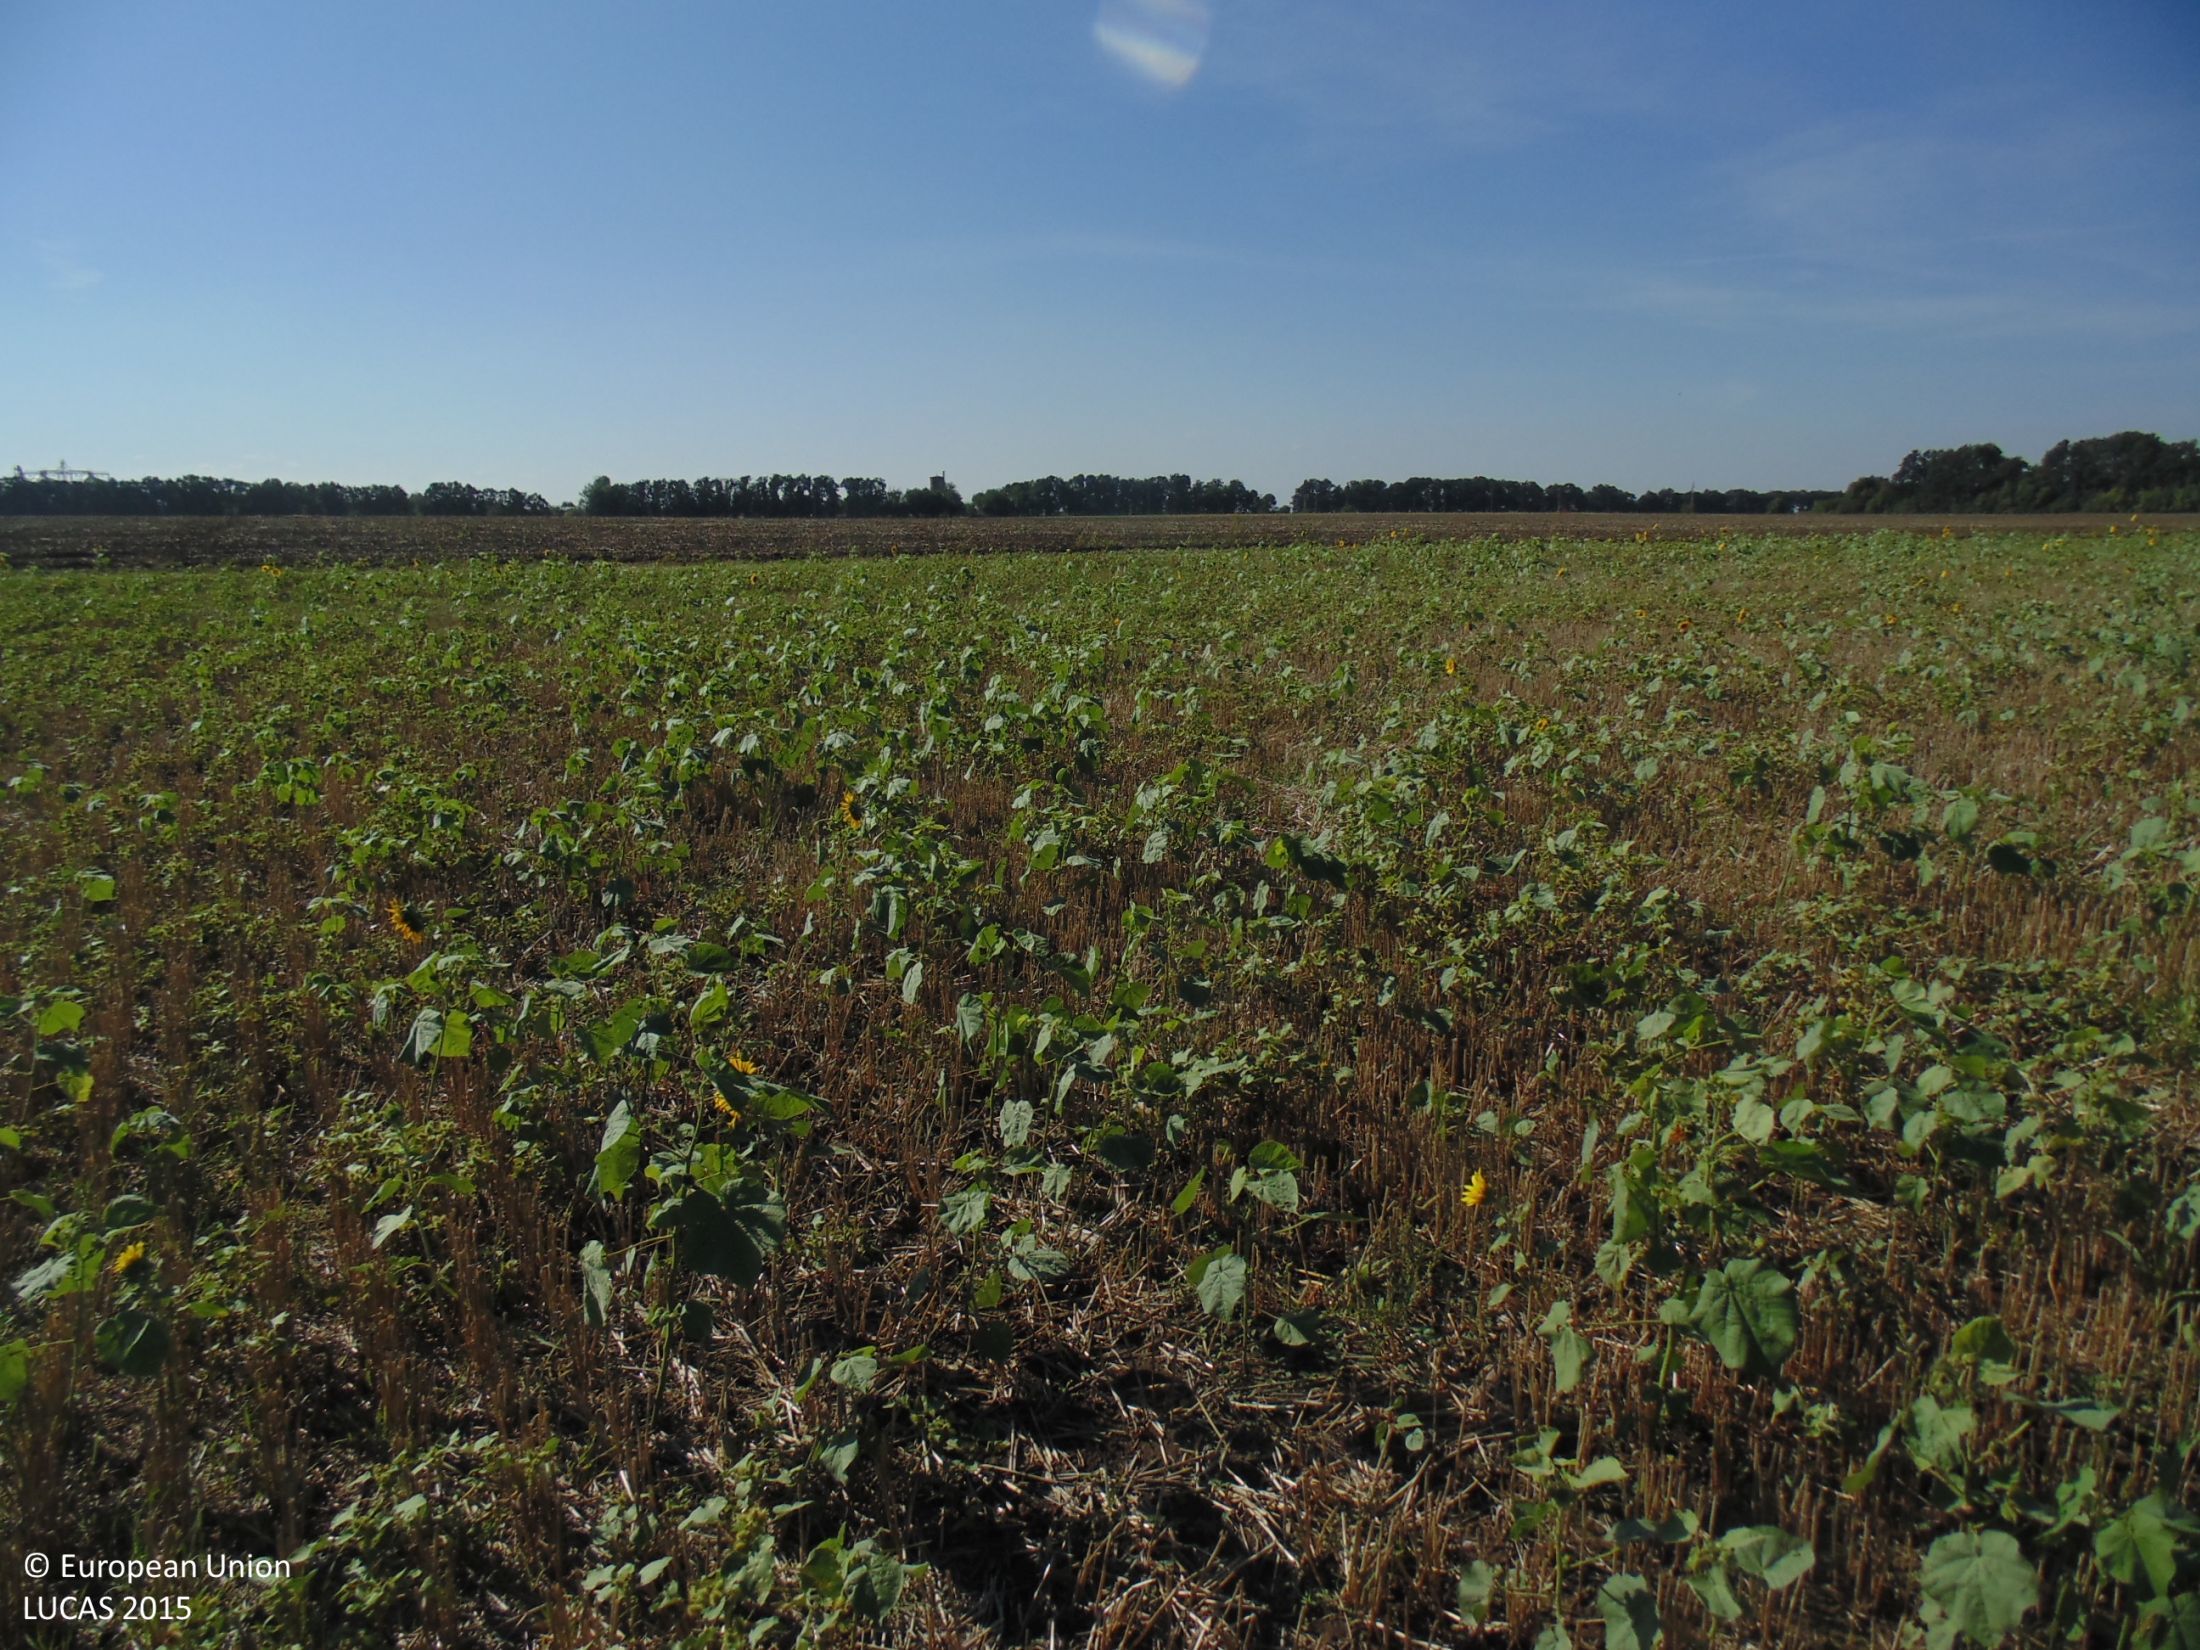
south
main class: Cropland
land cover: Common wheat
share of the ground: 10 - 25 %
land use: Agriculture (excluding fallow land and kitchen gardens)
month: September
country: BG
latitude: 44.0380
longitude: 27.0078
